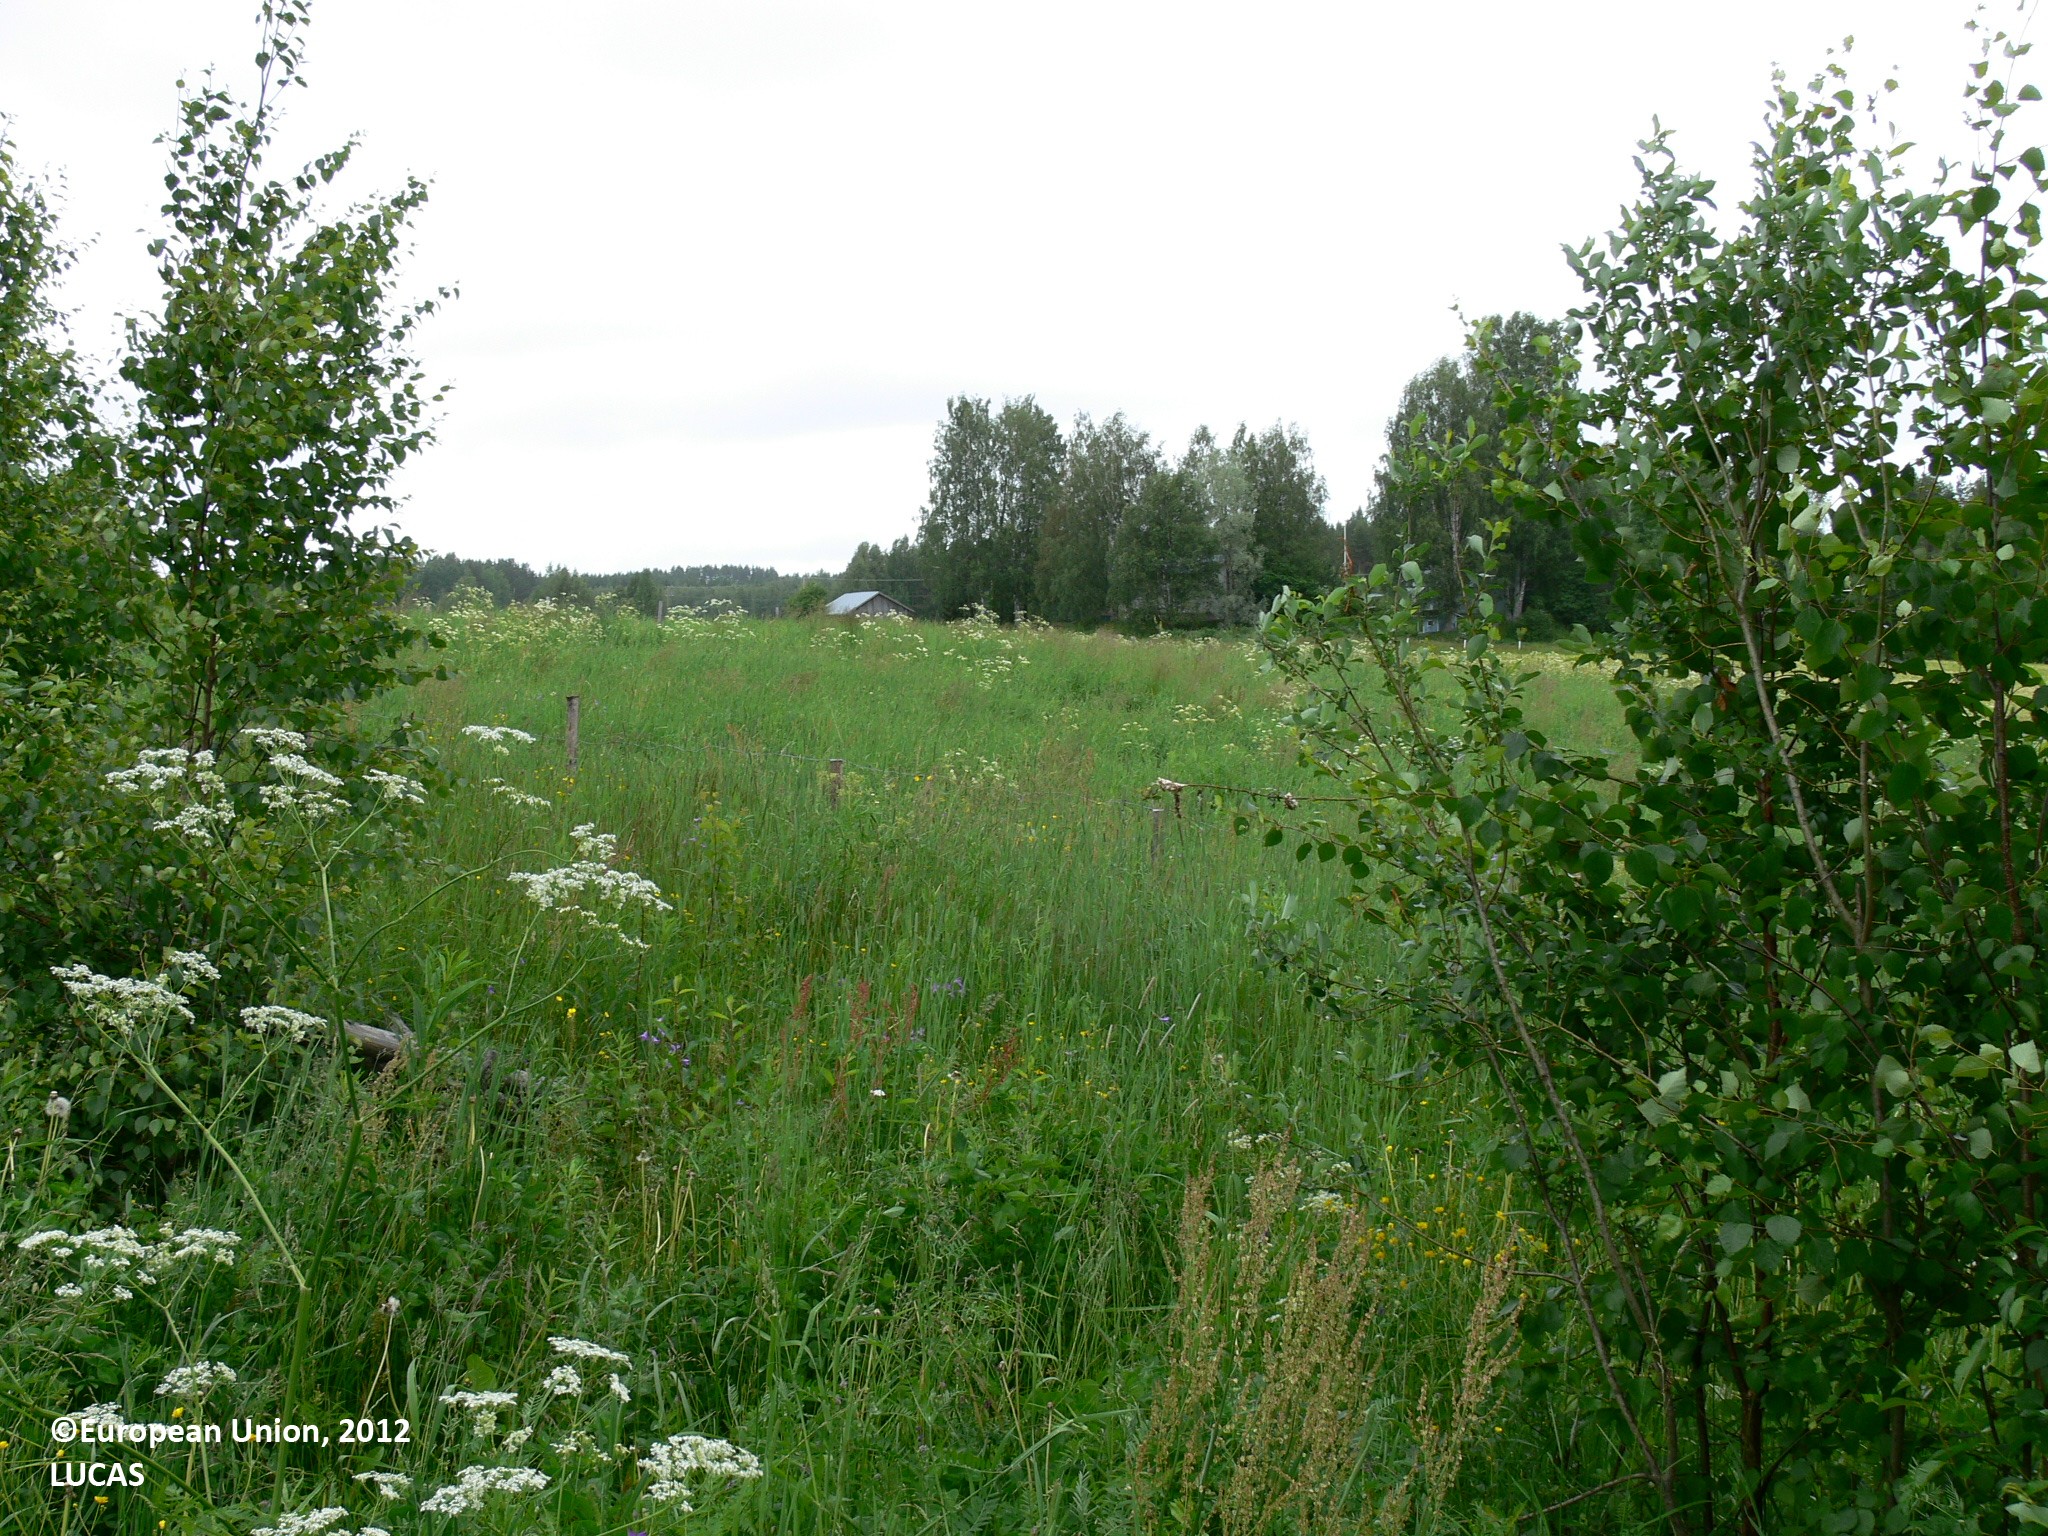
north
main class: Grassland
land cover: Spontaneously vegetated surfaces
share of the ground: > 75 %
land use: Fallow land
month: June
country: FI
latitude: 62.8118
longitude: 29.3572
